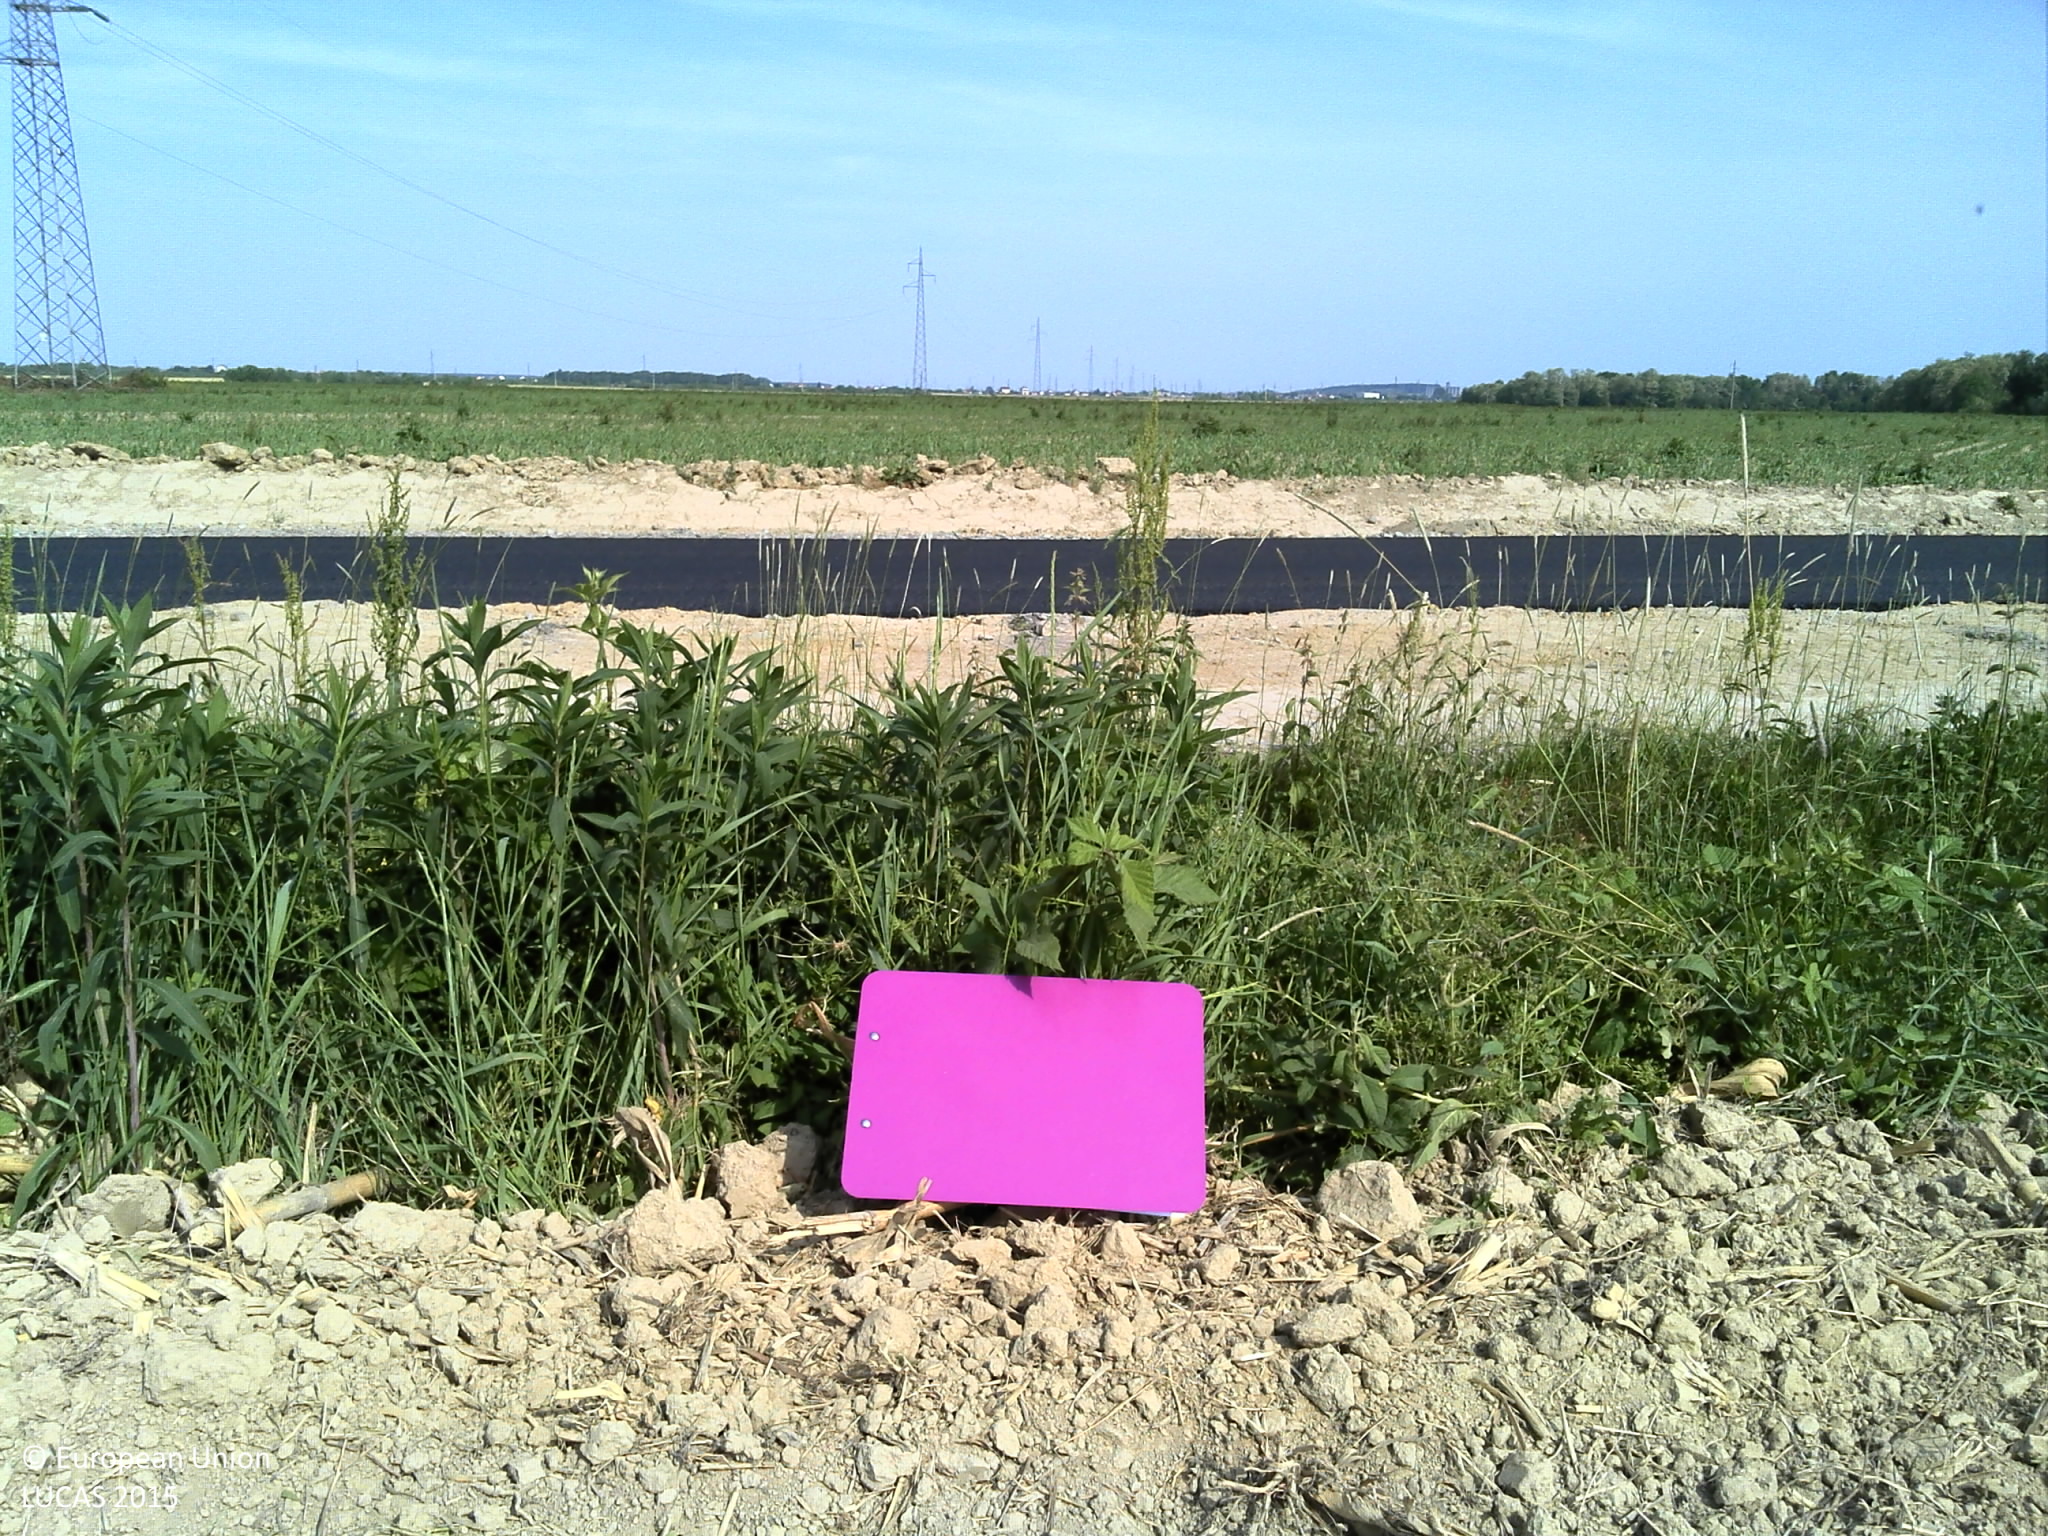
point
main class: Cropland
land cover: Maize
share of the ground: < 10 %
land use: Agriculture (excluding fallow land and kitchen gardens)
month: May
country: HR
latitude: 45.5220
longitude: 18.0570
